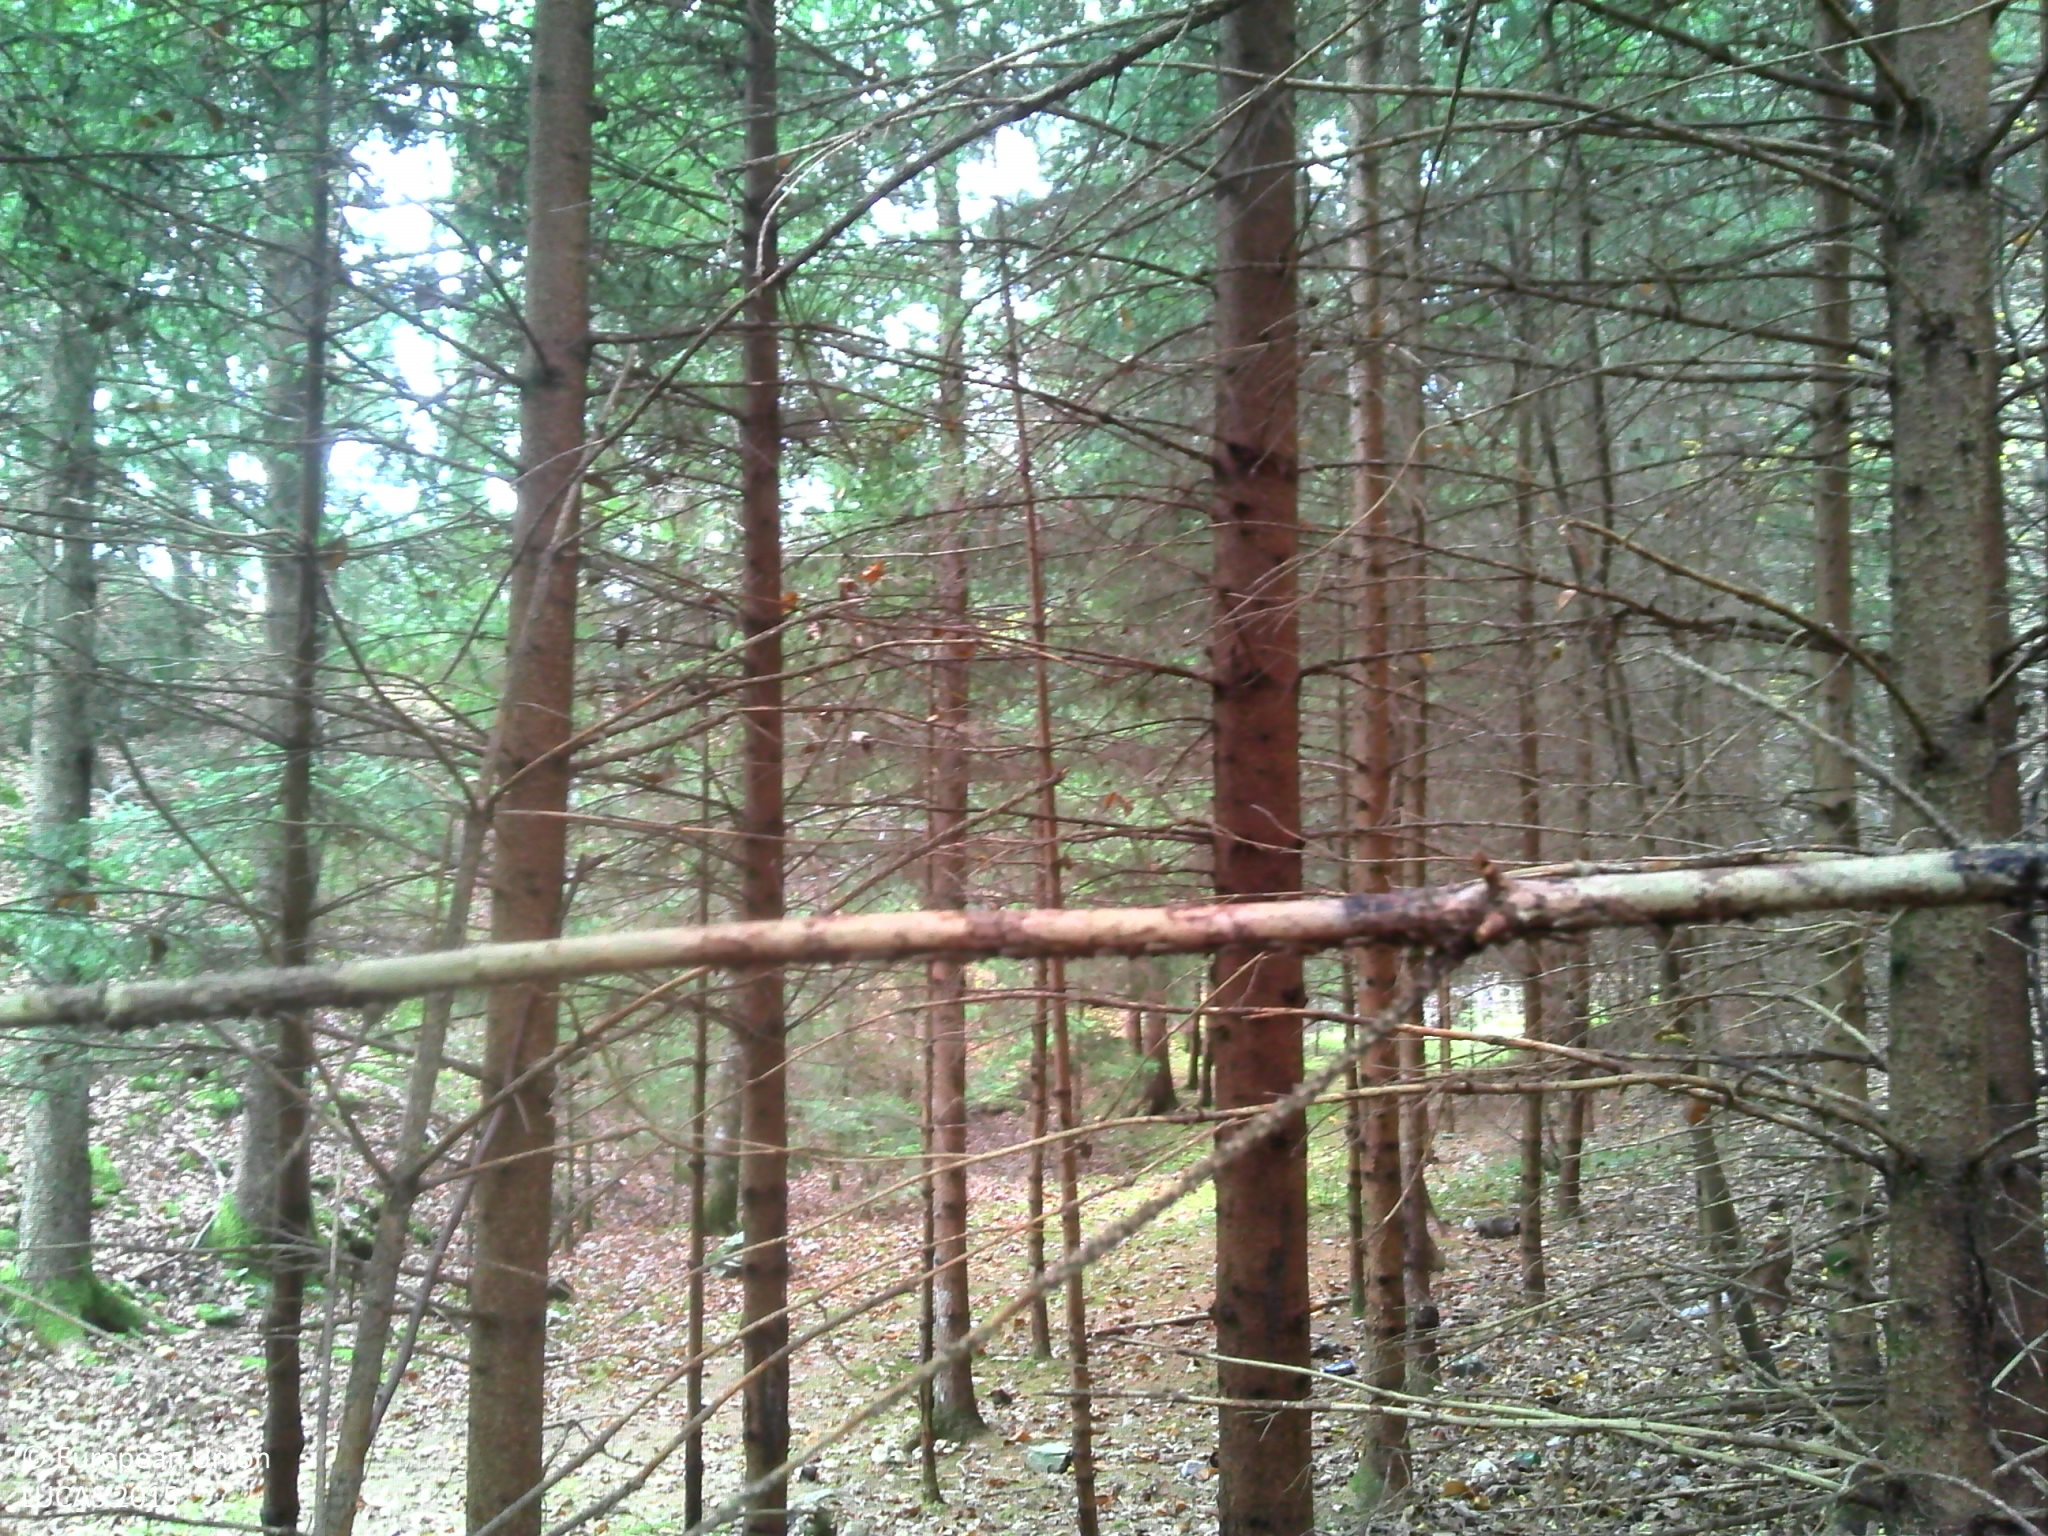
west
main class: Woodland
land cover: Spruce dominated mixed woodland
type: hemiboreal forest and nemoral coniferous forest and mixed broadleaved-coniferous forest
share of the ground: > 75 %
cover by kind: coniferous forest trees 50 %, broadleaved forest trees 40 %, consolidated bare surface 10 %
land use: Forestry
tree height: > 5 m
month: November
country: FR
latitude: 45.7160
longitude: 6.4713
